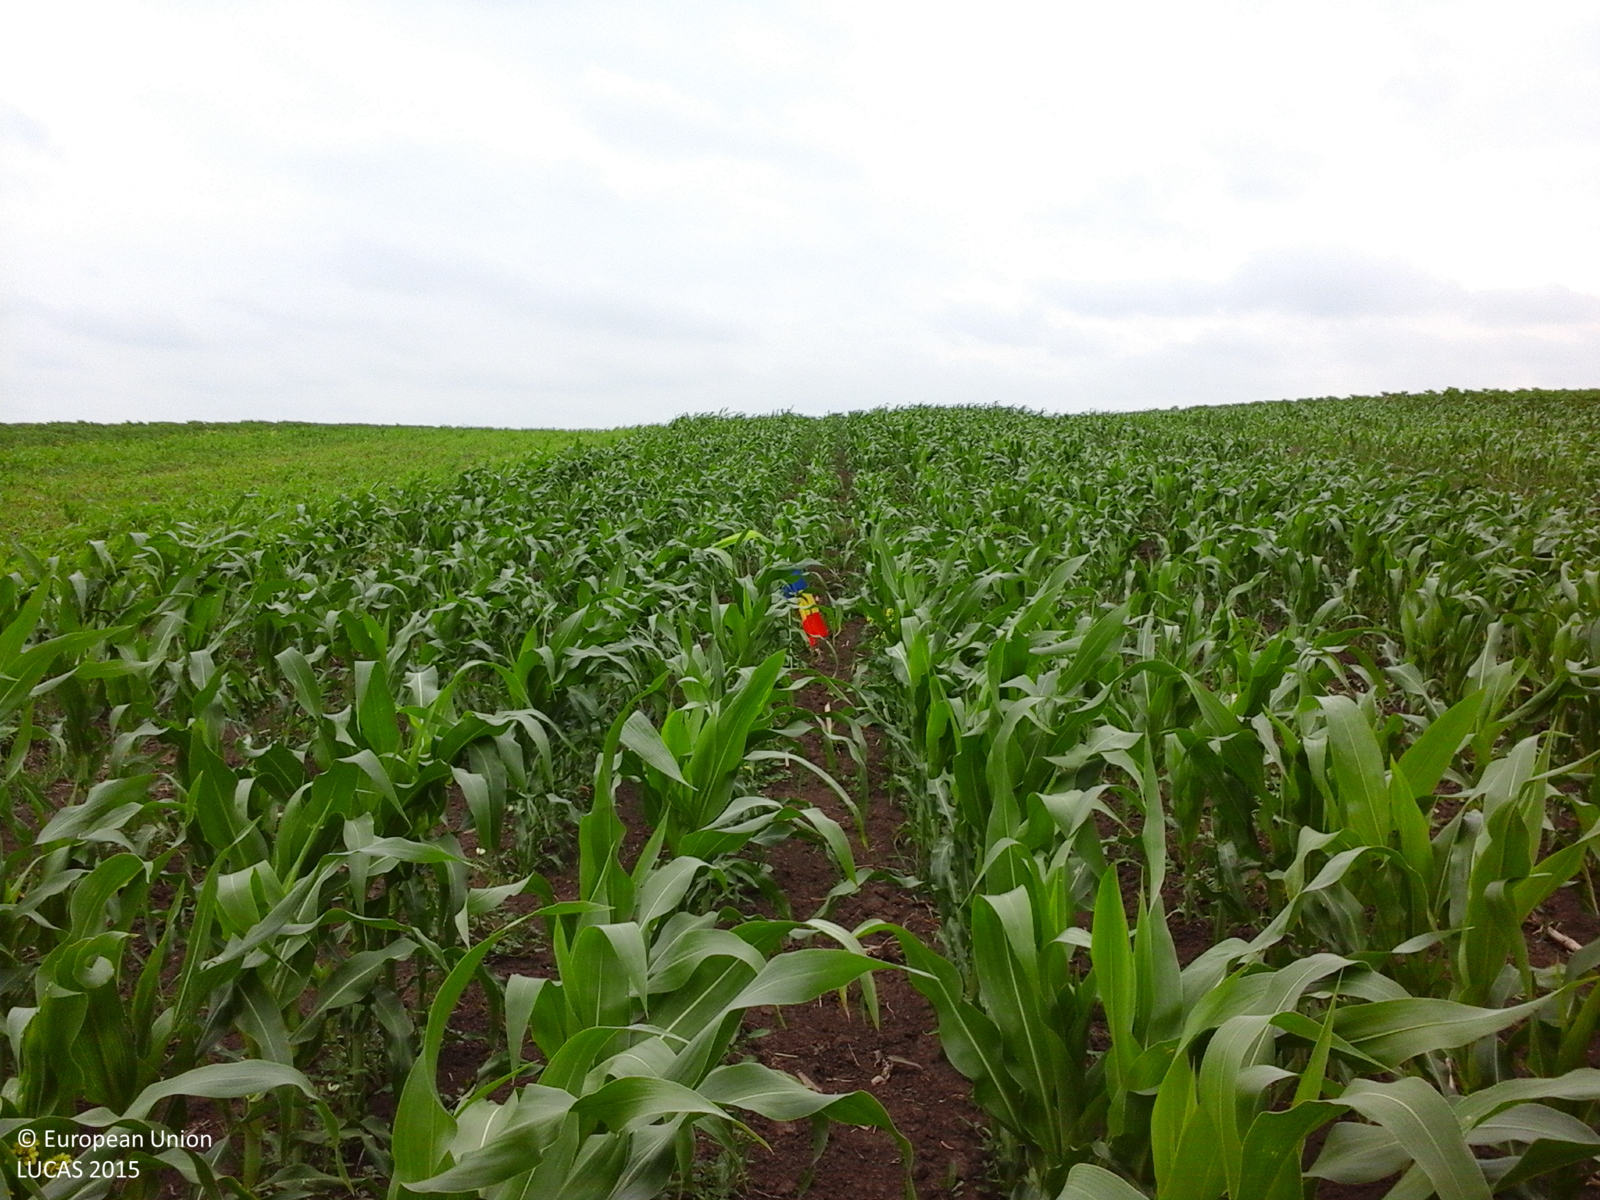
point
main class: Cropland
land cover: Maize
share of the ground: > 75 %
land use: Agriculture (excluding fallow land and kitchen gardens)
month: June
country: RO
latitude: 47.9688
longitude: 26.4451
